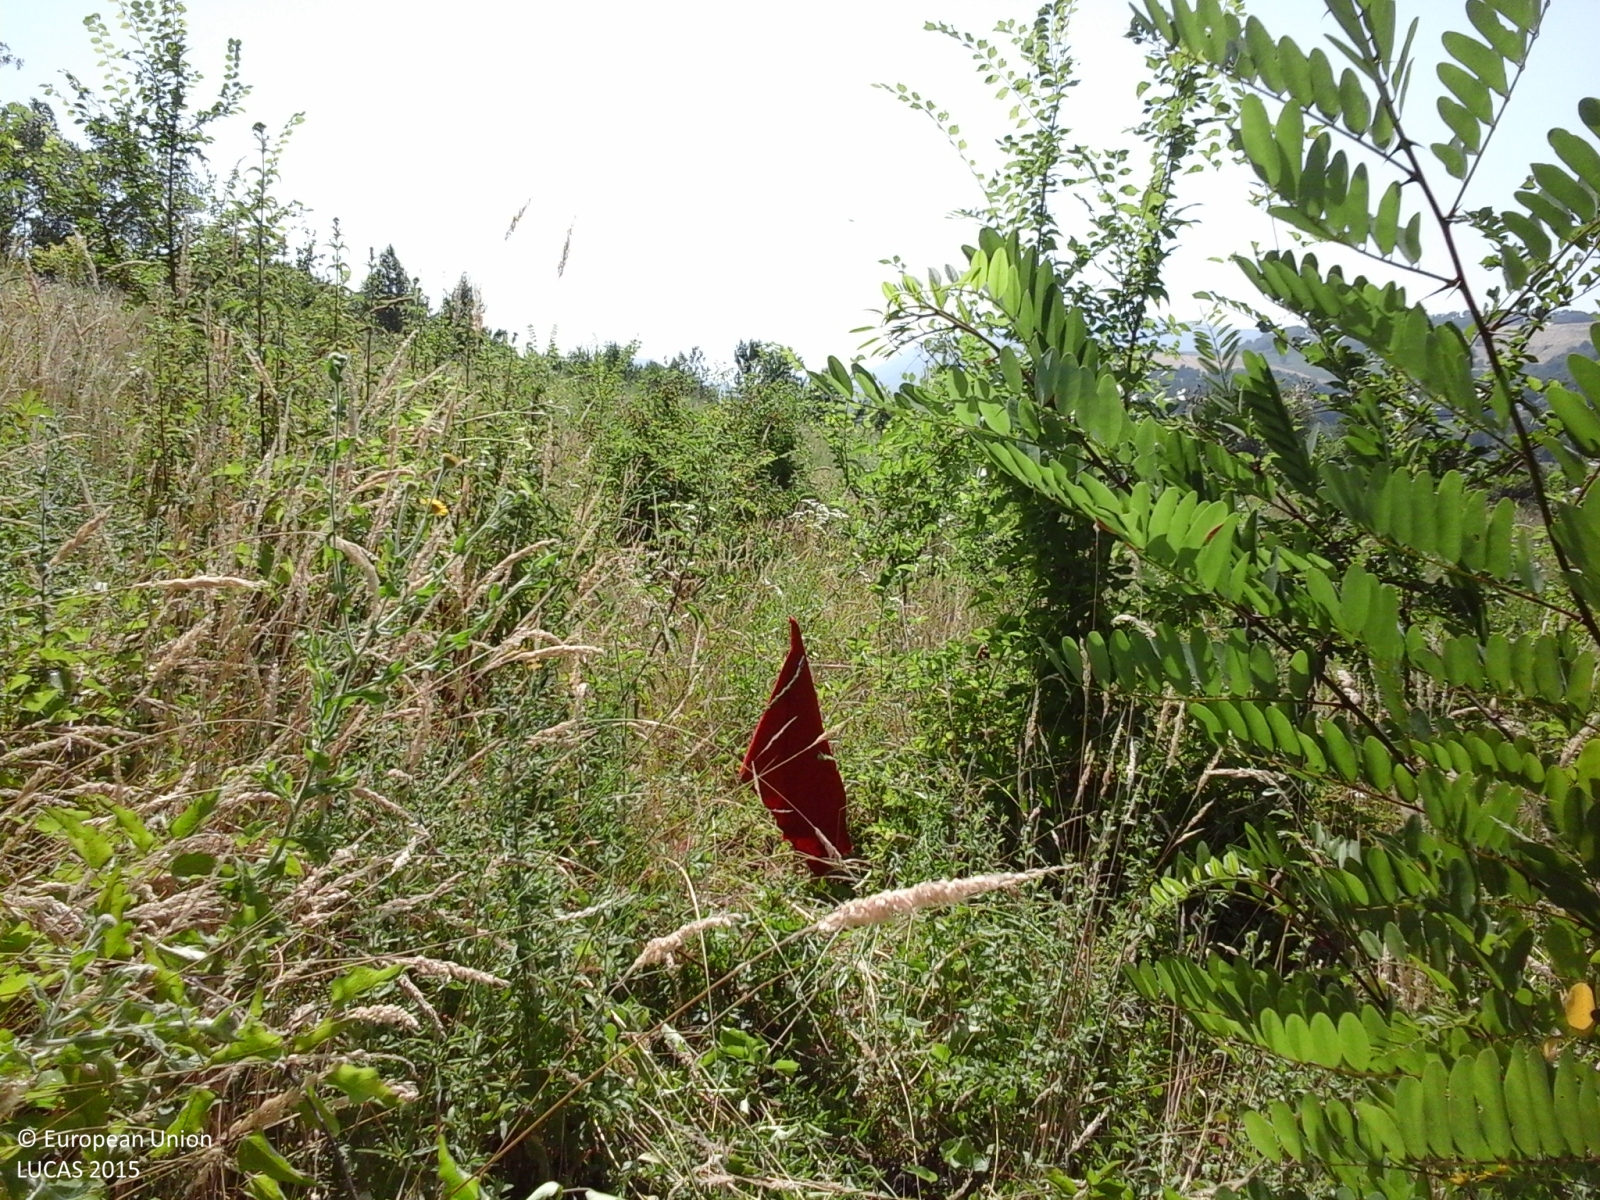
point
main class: Grassland
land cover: Grassland with sparse tree/shrub cover
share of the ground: > 75 %
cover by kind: herbaceous plants 95 %, broadleaved forest trees 5 %
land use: Abandoned areas
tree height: < 5 m
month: July
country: IT
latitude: 43.0875
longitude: 13.3199
